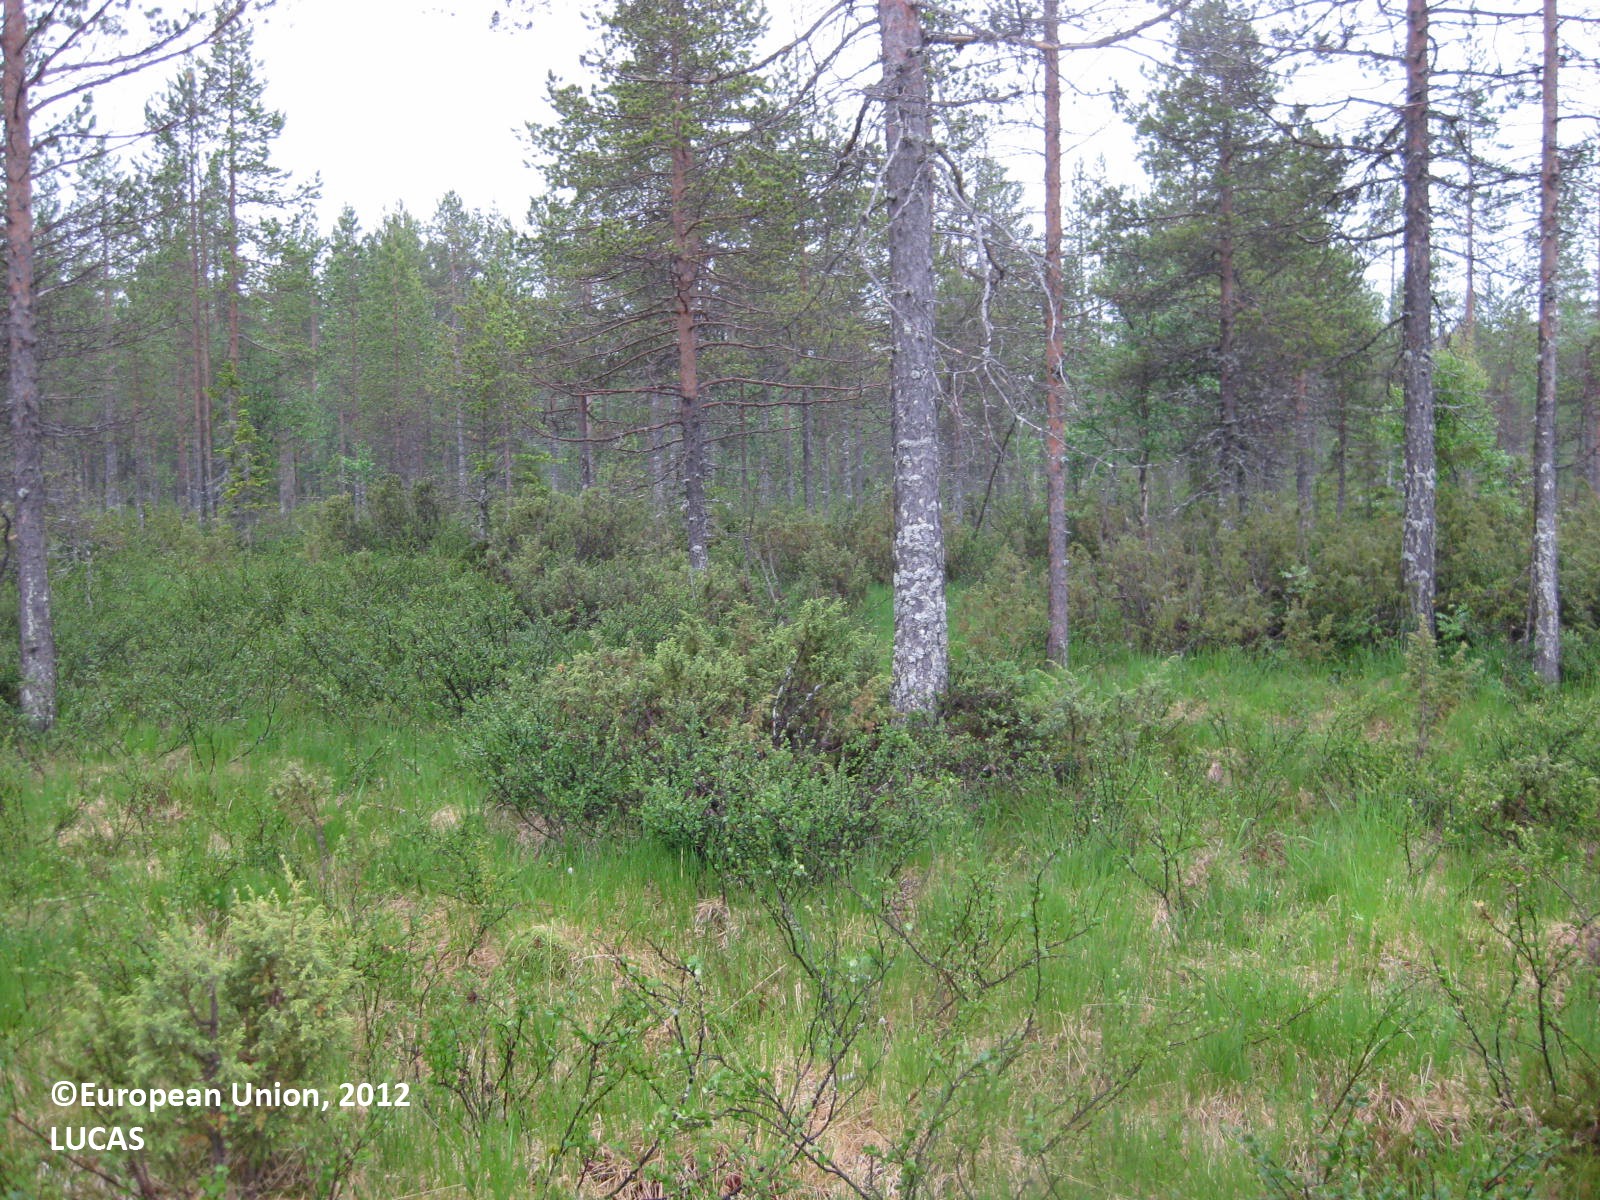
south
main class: Woodland
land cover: Pine dominated coniferous woodland
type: boreal forest
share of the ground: 25 - 50 %
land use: Forestry
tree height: > 5 m
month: July
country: FI
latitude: 65.6479
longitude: 29.4733
